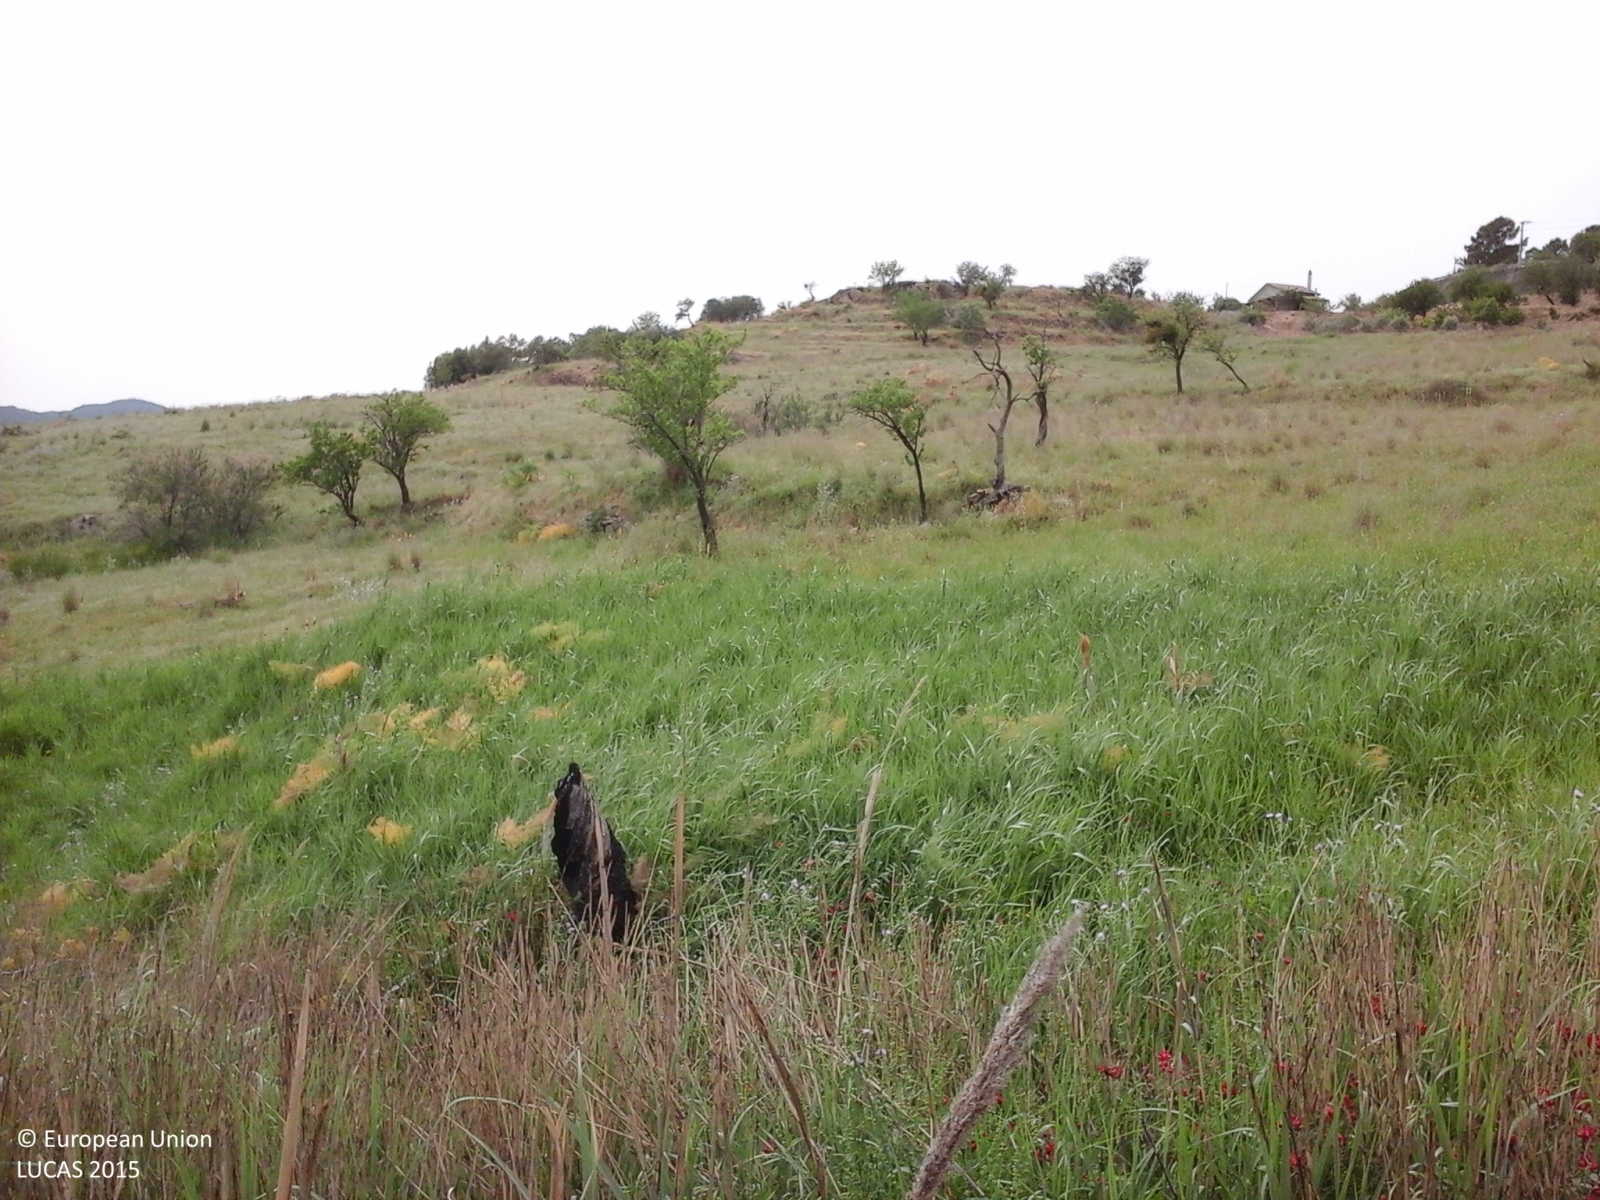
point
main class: Grassland
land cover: Spontaneously vegetated surfaces
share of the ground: > 75 %
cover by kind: herbaceous plants 100 %
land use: Agriculture (excluding fallow land and kitchen gardens)
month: May
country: IT
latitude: 37.8061
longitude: 14.8391
